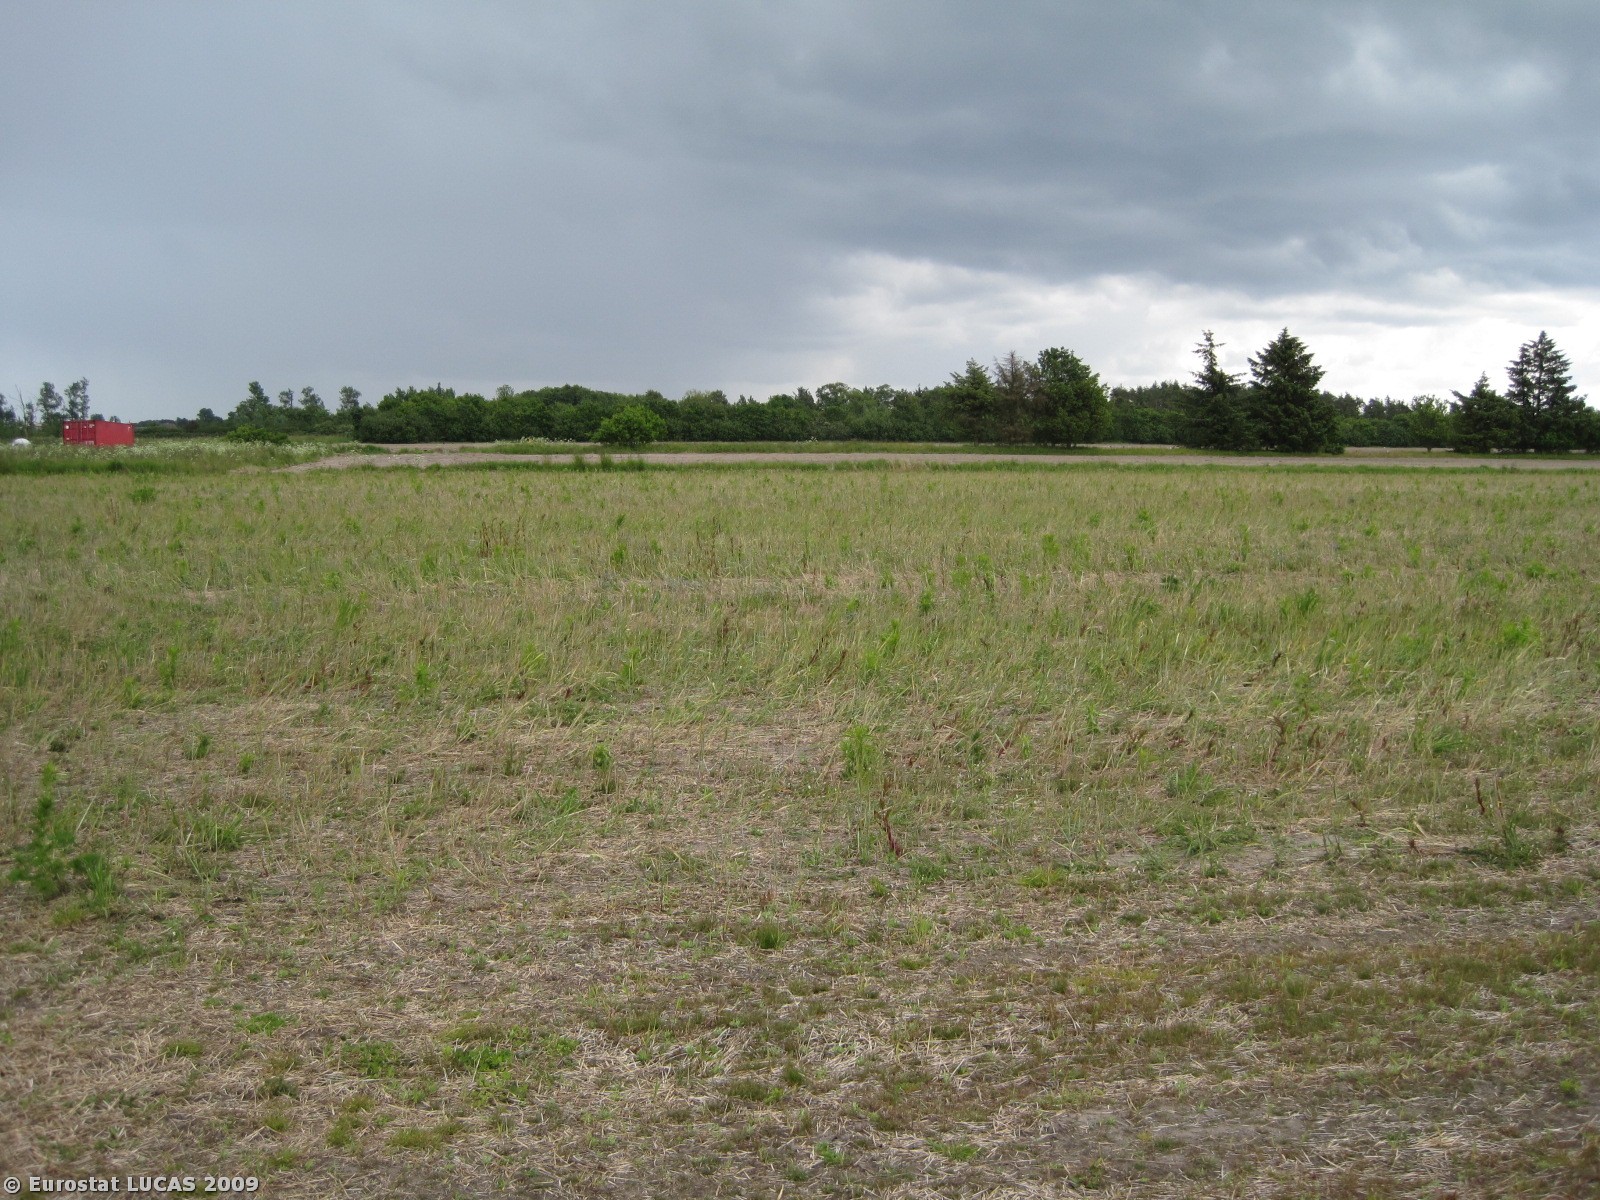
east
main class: Grassland
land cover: Grassland without tree/shrub cover
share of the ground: > 75 %
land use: Agriculture (excluding fallow land and kitchen gardens)
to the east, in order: Grassland without tree/shrub cover; Fences; Temporary grasslands; Grass margins; Bare land; Grass margins; Coniferous woodland; Grass margins; Bare land
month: June
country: DK
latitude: 56.9964
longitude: 10.2794
